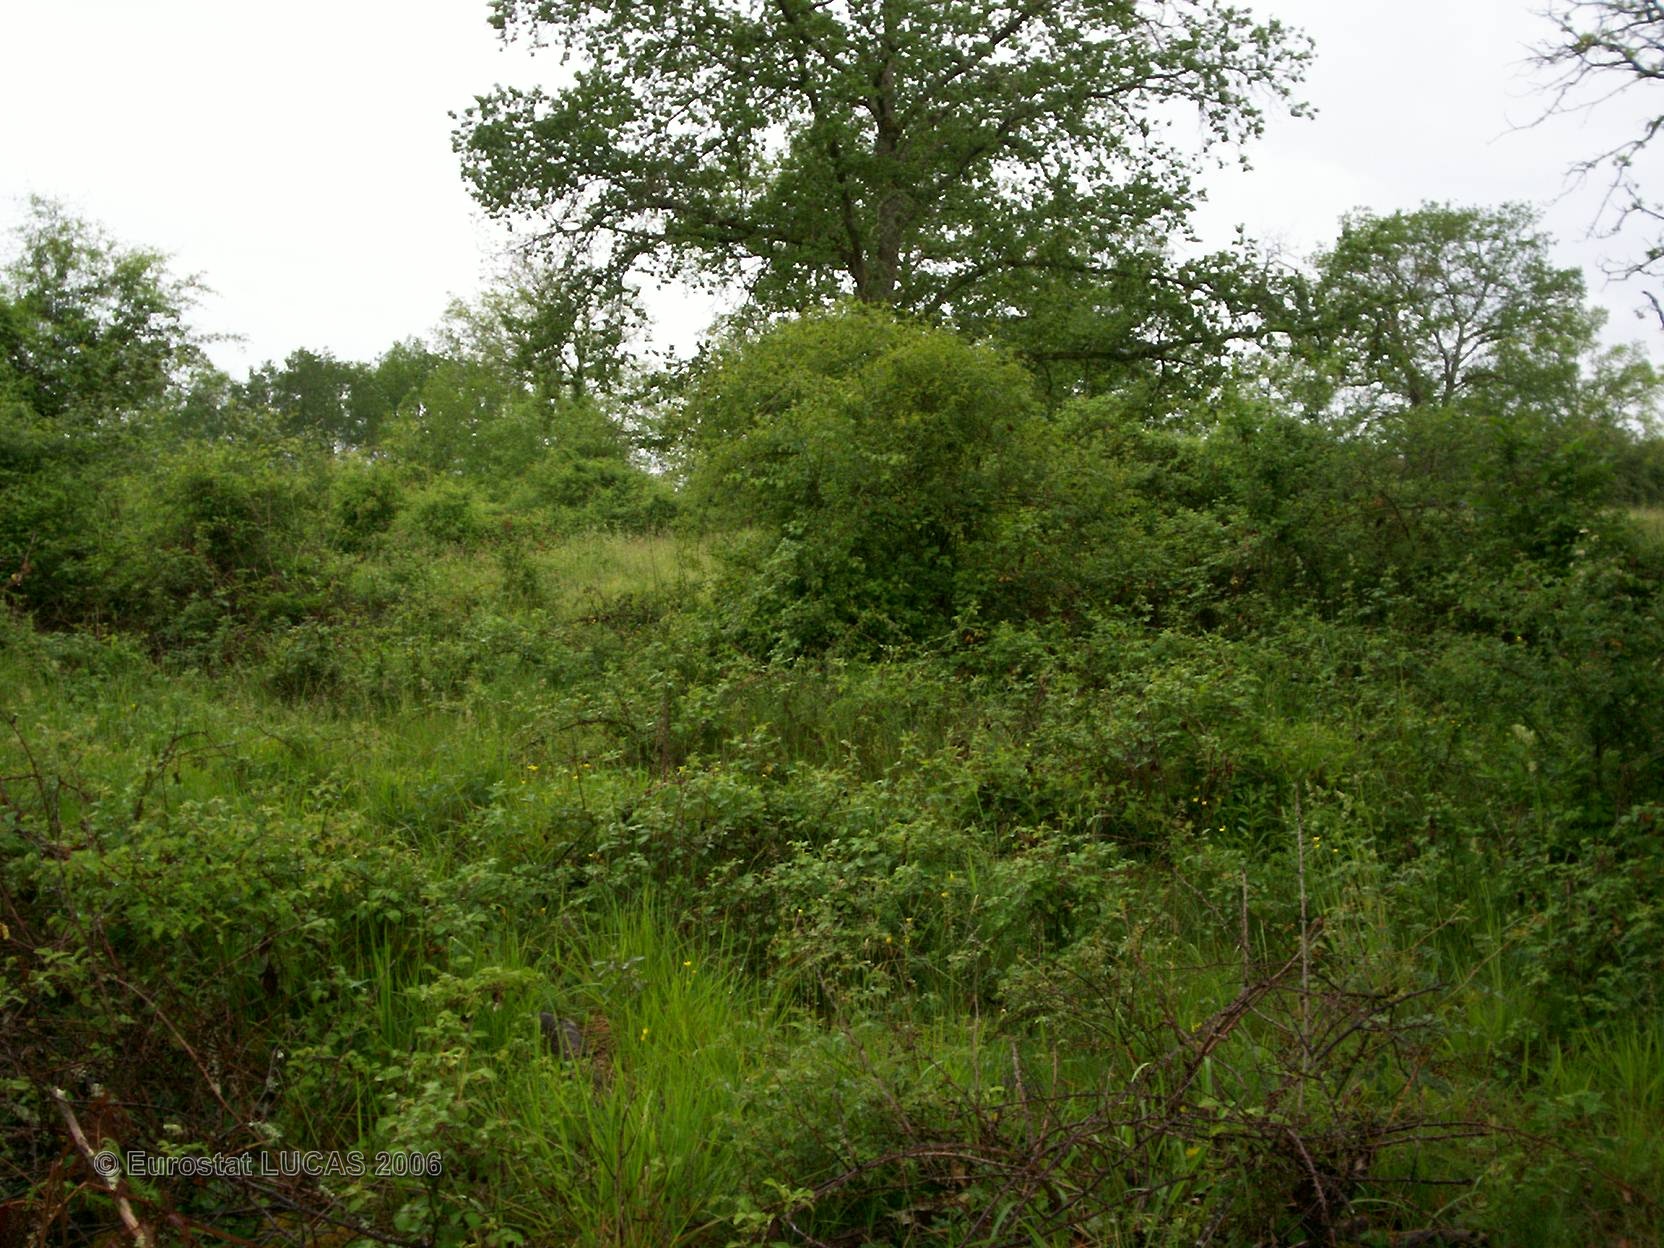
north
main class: Grassland
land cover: Grassland with sparse tree/shrub cover
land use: Agriculture (excluding fallow land and kitchen gardens)
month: May
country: FR
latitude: 45.4058
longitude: 0.5461
